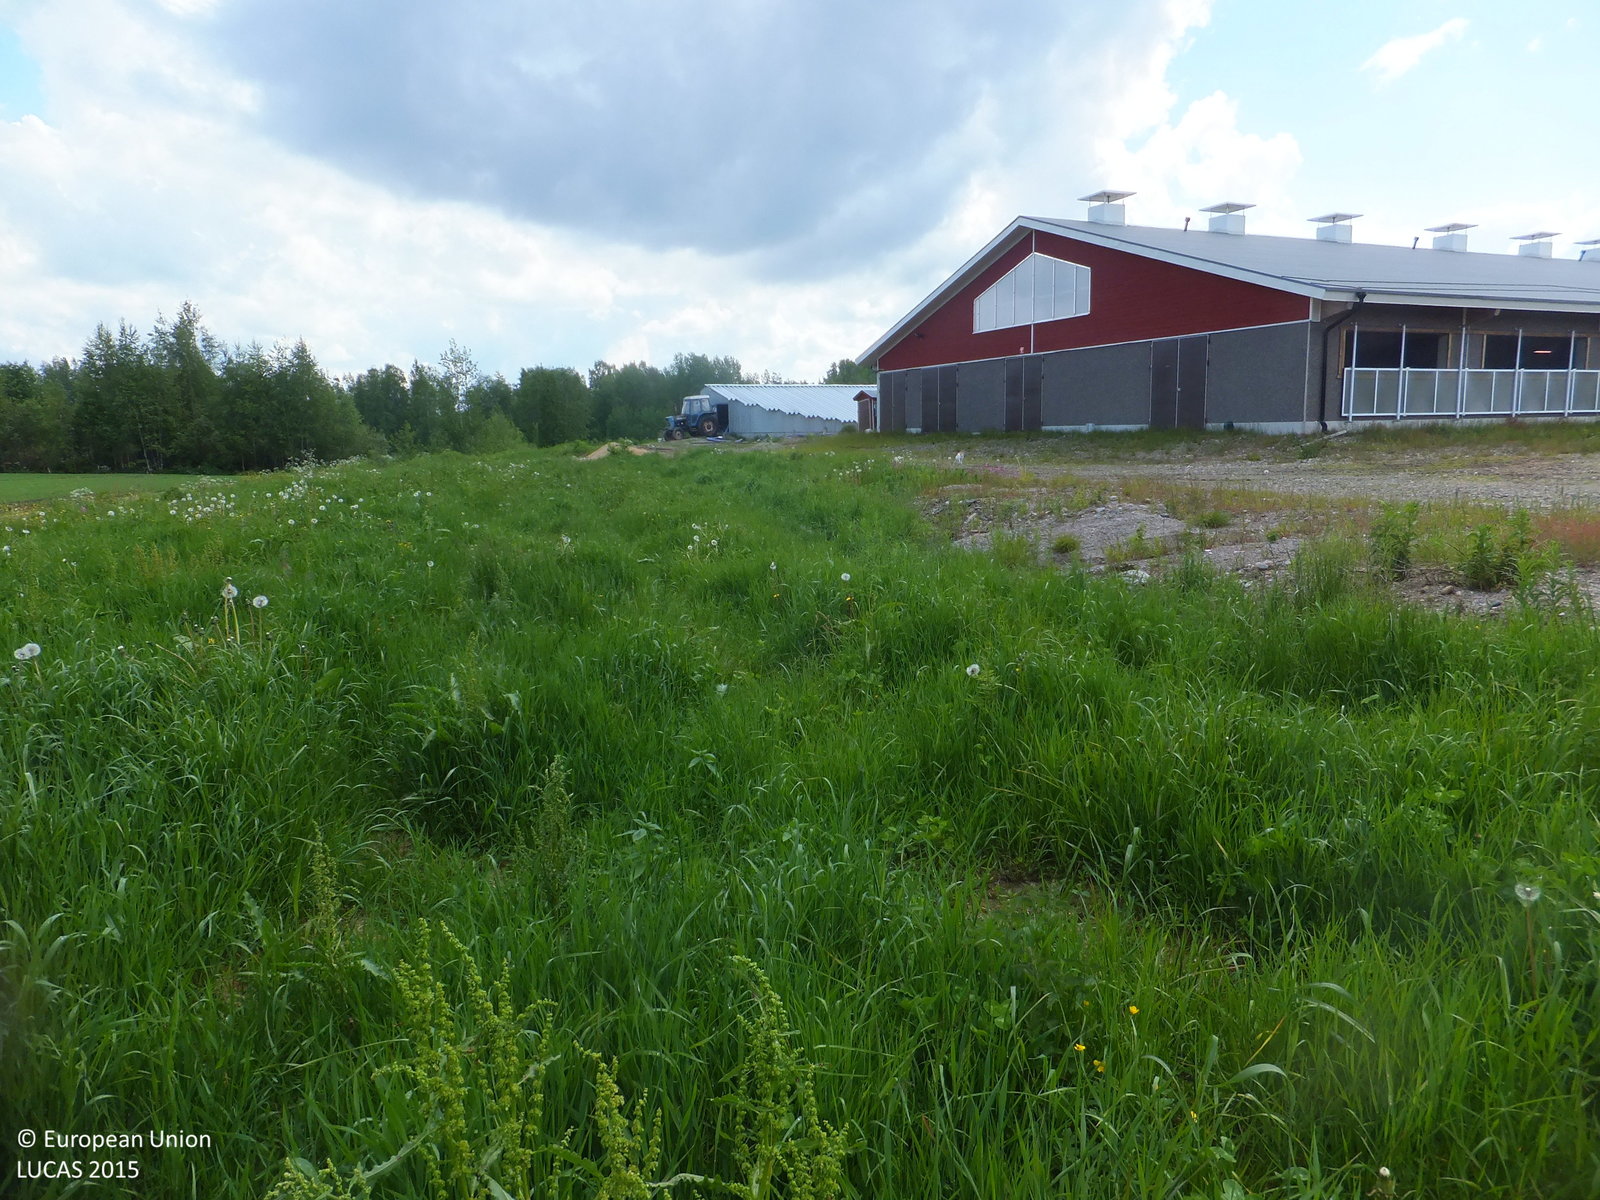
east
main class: Grassland
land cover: Grassland without tree/shrub cover
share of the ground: > 75 %
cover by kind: herbaceous plants 100 %
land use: Agriculture (excluding fallow land and kitchen gardens)
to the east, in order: Grassland without tree/shrub cover; Ditches and canals; Grass margins; Paved roads, cycling and walking lanes; Barley; Ditches and canals; Broadleaved woodland; Barley; Ditches and canals; Dry stone walls; Broadleaved woodland
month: June
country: FI
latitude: 63.6430
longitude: 24.0199
